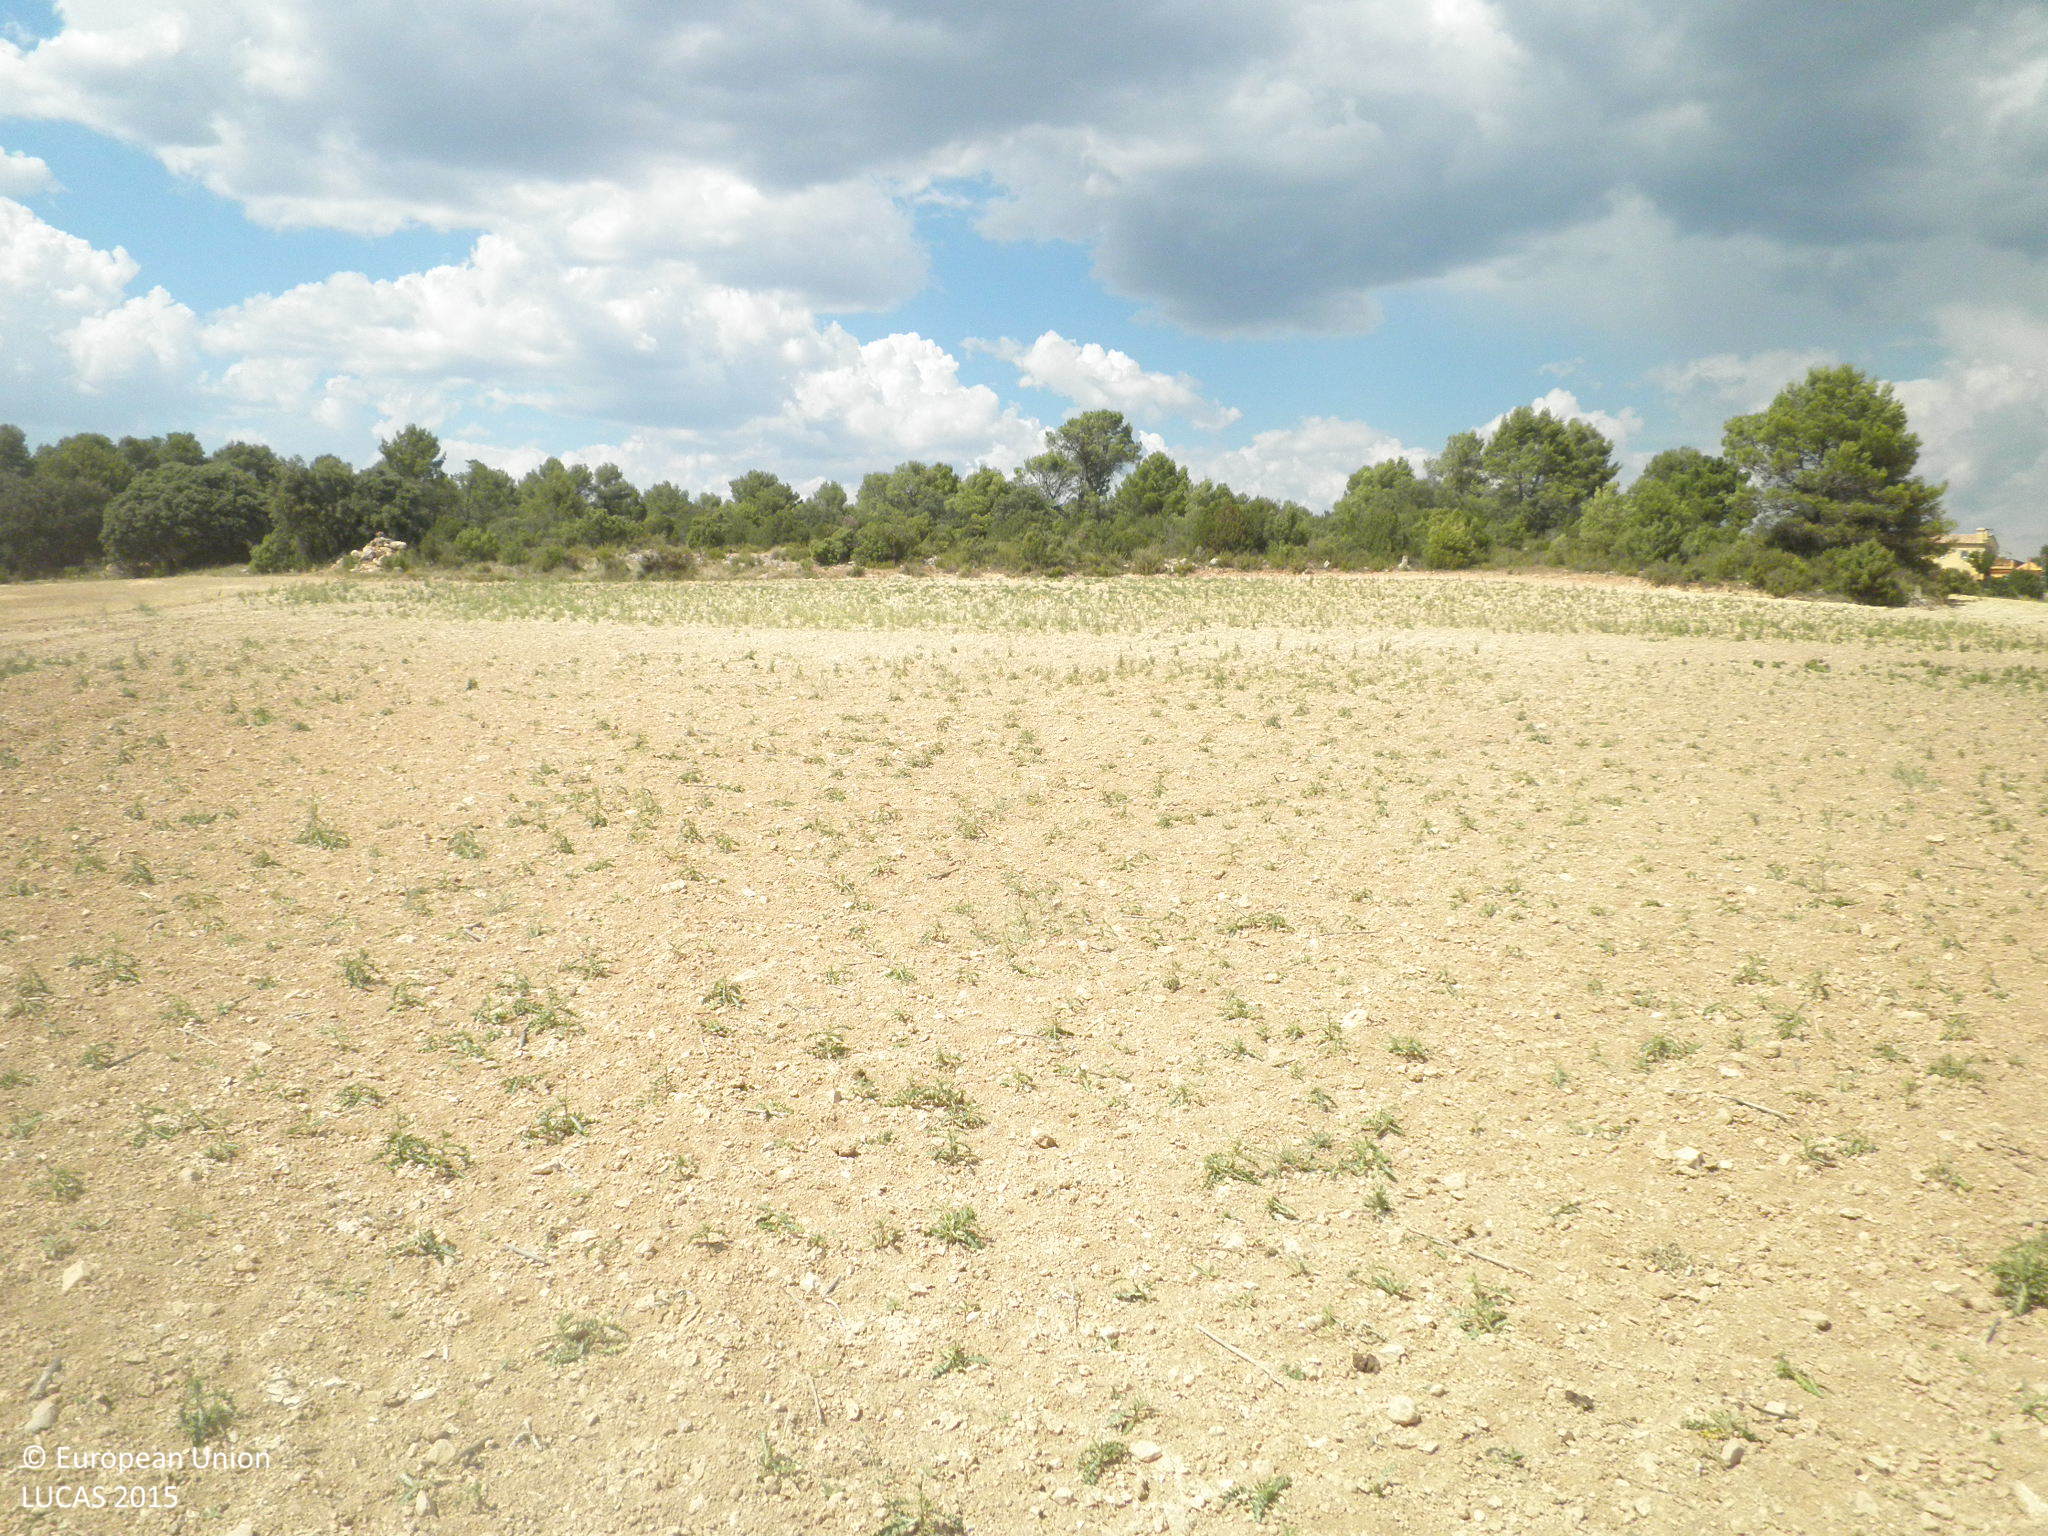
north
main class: Grassland
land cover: Spontaneously vegetated surfaces
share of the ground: 10 - 25 %
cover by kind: unconsolidated bare surface 90 %, herbaceous plants 10 %
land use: Fallow land
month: July
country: ES
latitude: 39.6413
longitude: -1.6711
